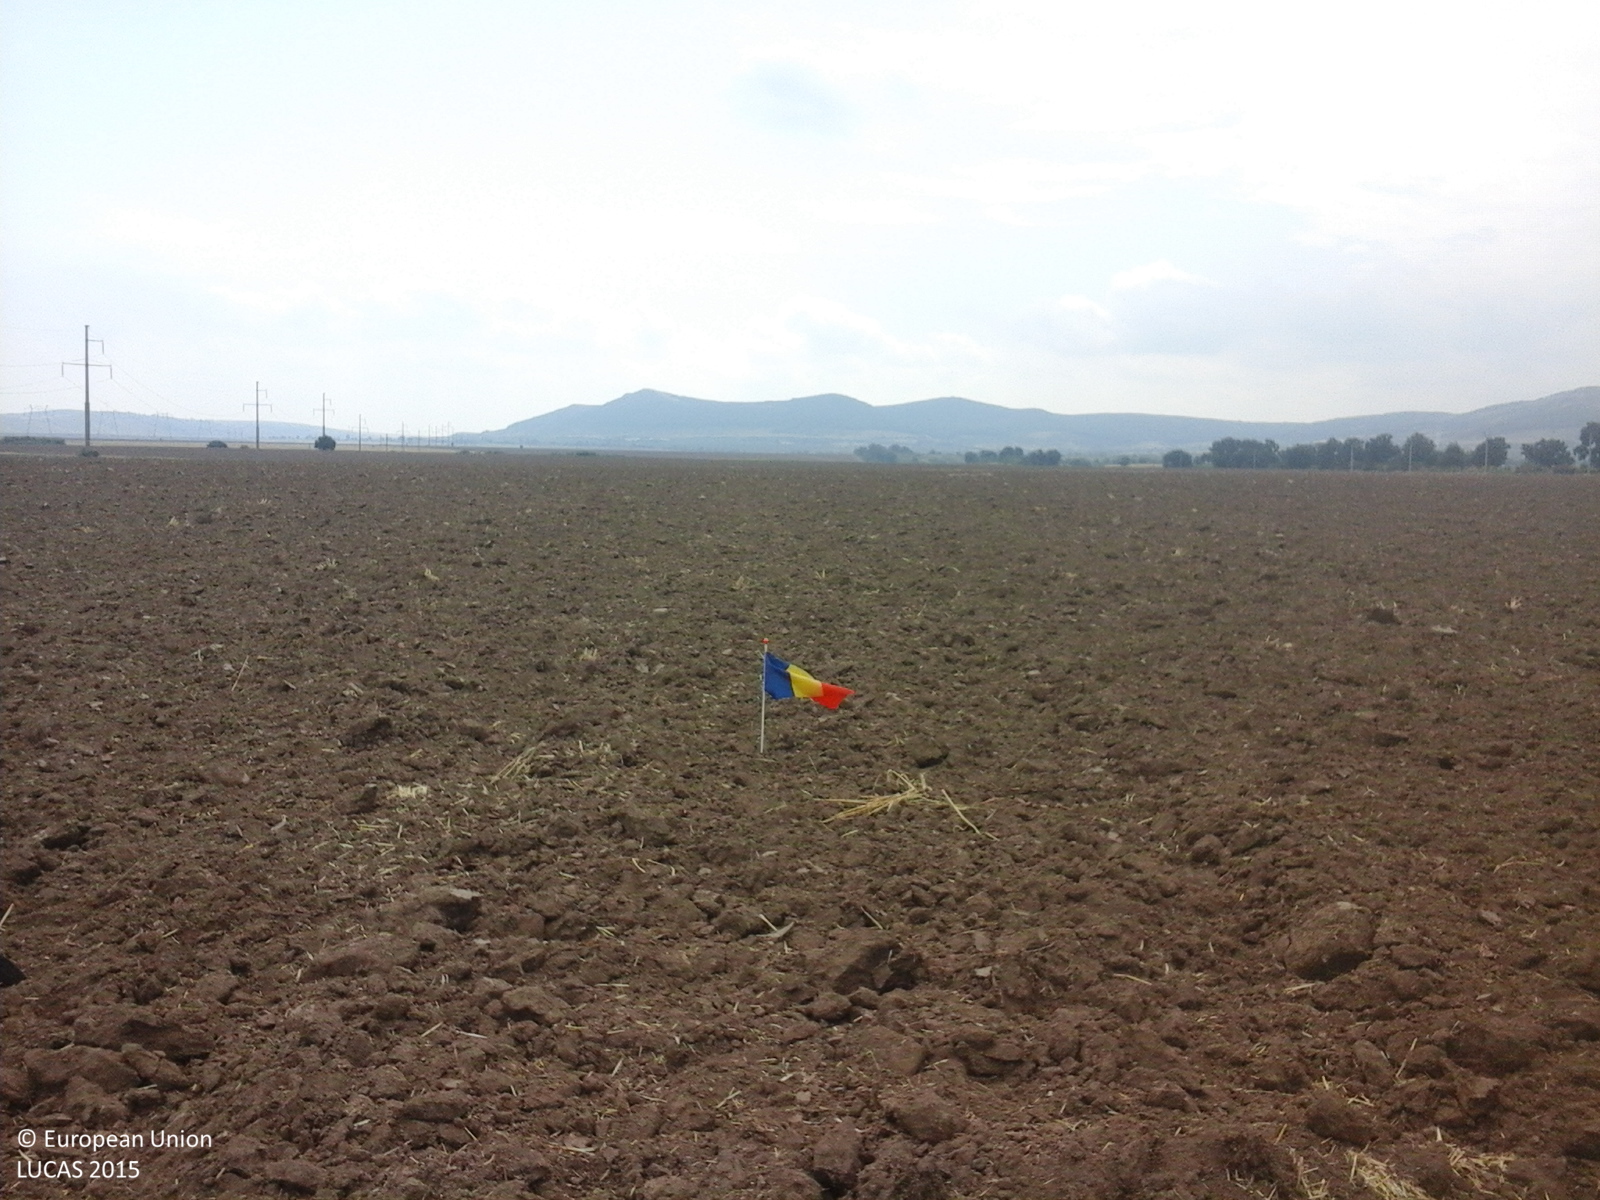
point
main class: Cropland
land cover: Common wheat
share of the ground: < 10 %
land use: Agriculture (excluding fallow land and kitchen gardens)
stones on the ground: < 10 %
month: July
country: RO
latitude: 45.2208
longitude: 28.4815
